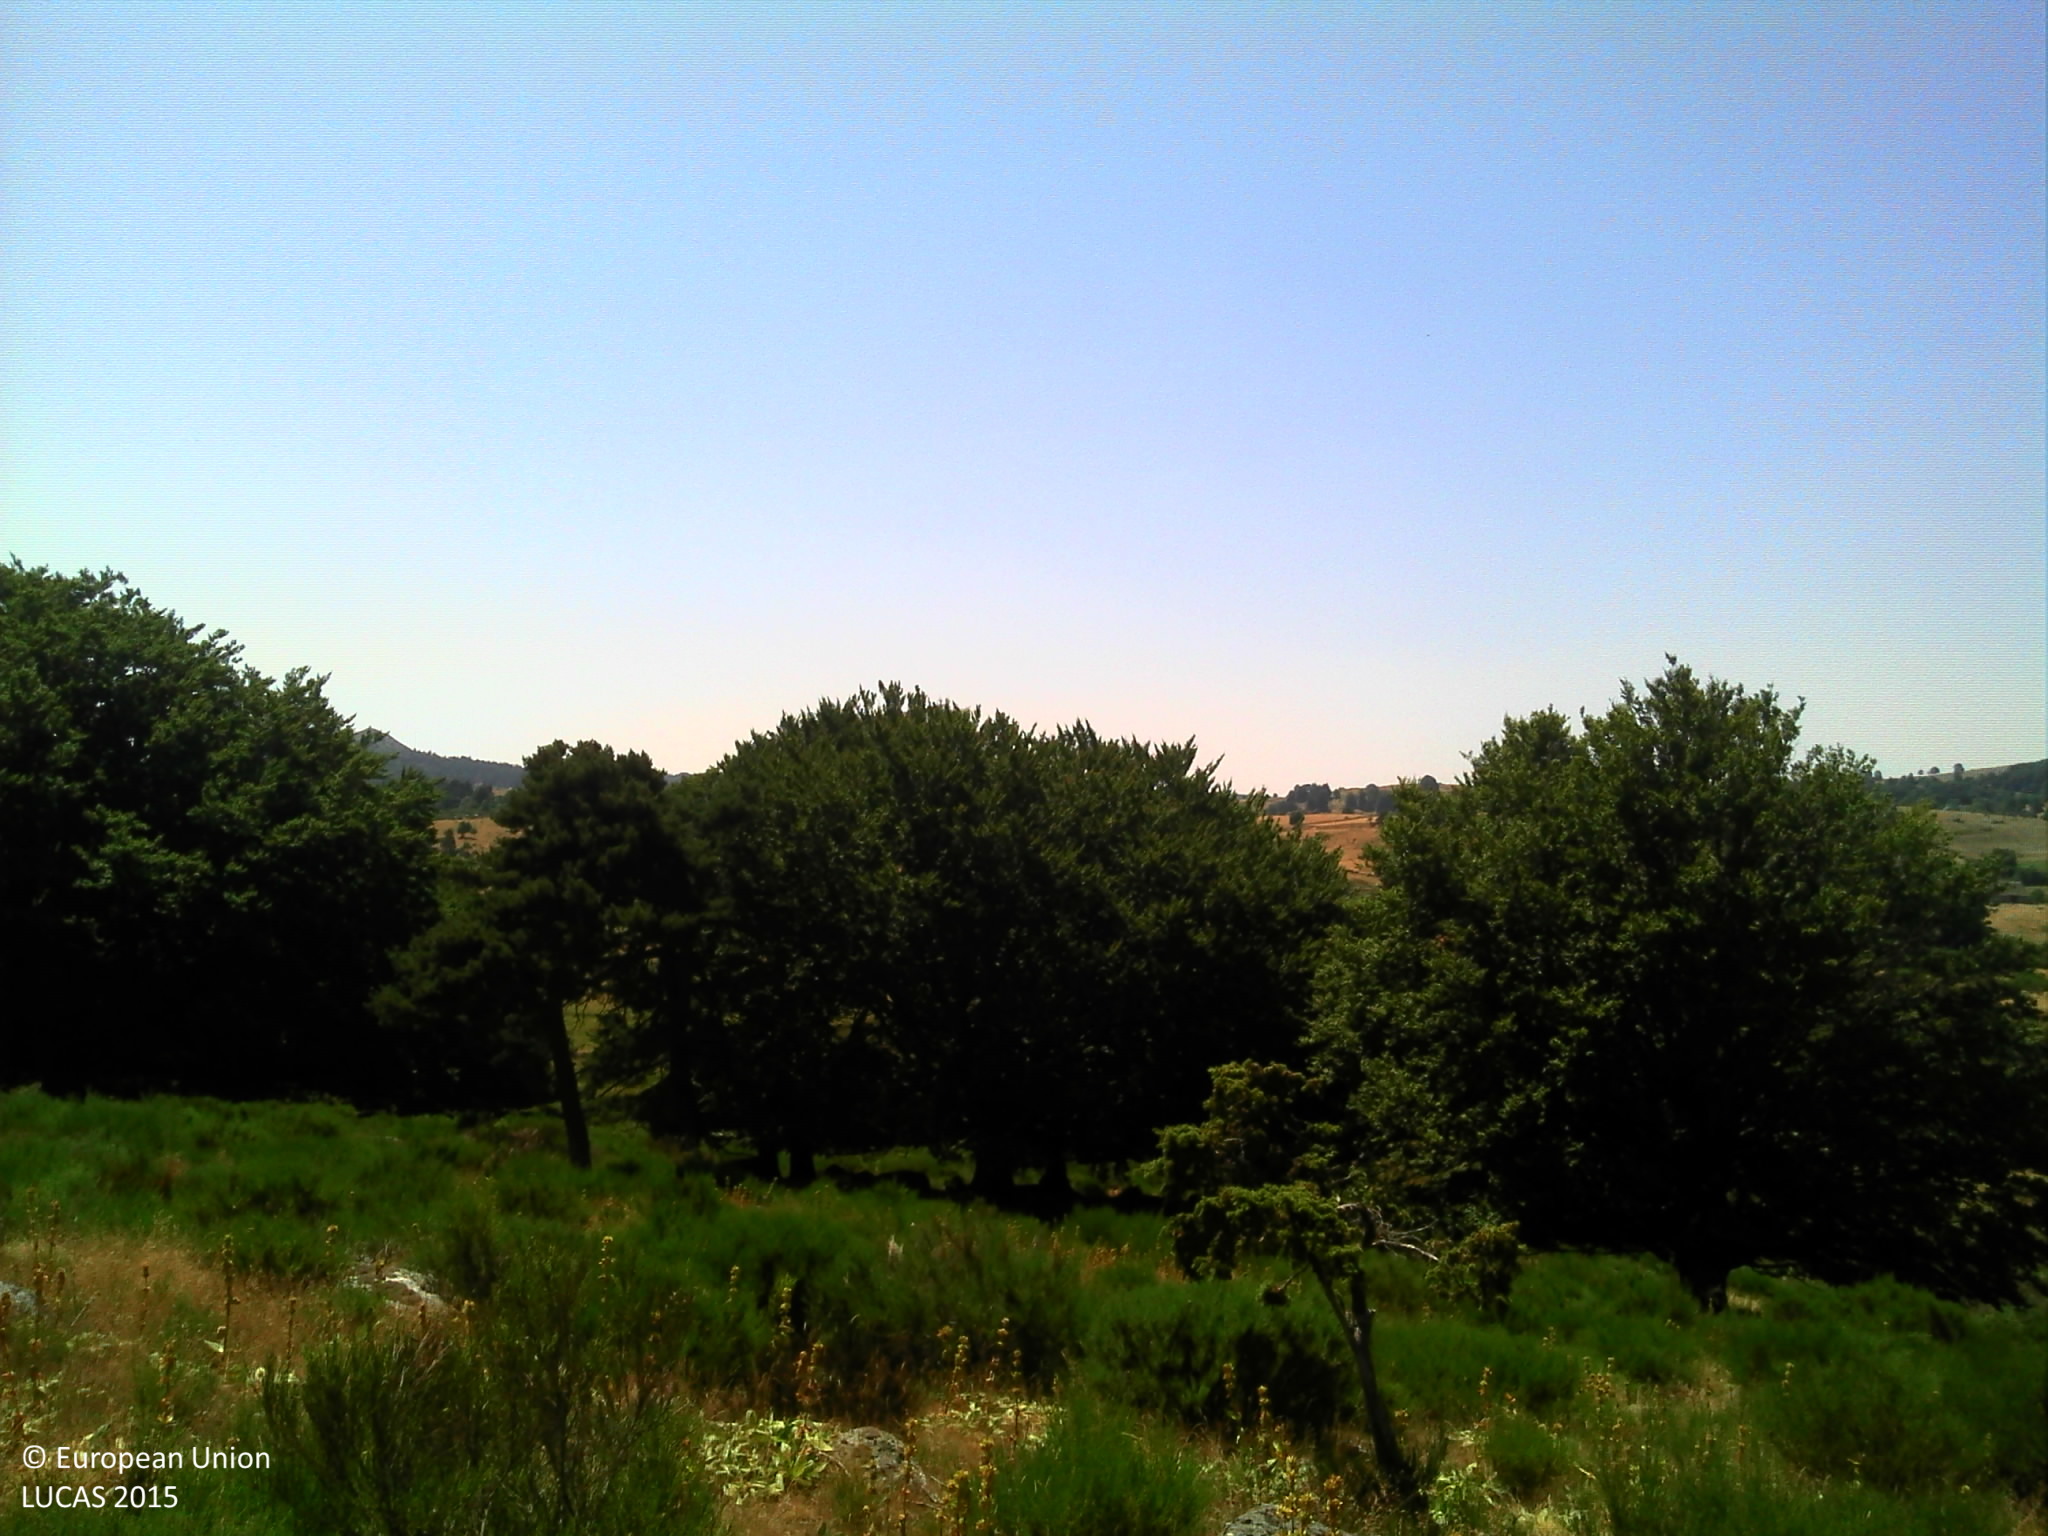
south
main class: Shrubland
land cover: Shrubland without tree cover
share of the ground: > 75 %
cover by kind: shrubs 90 %, herbaceous plants 10 %
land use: Agriculture (excluding fallow land and kitchen gardens)
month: July
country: FR
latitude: 44.6330
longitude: 3.1844
